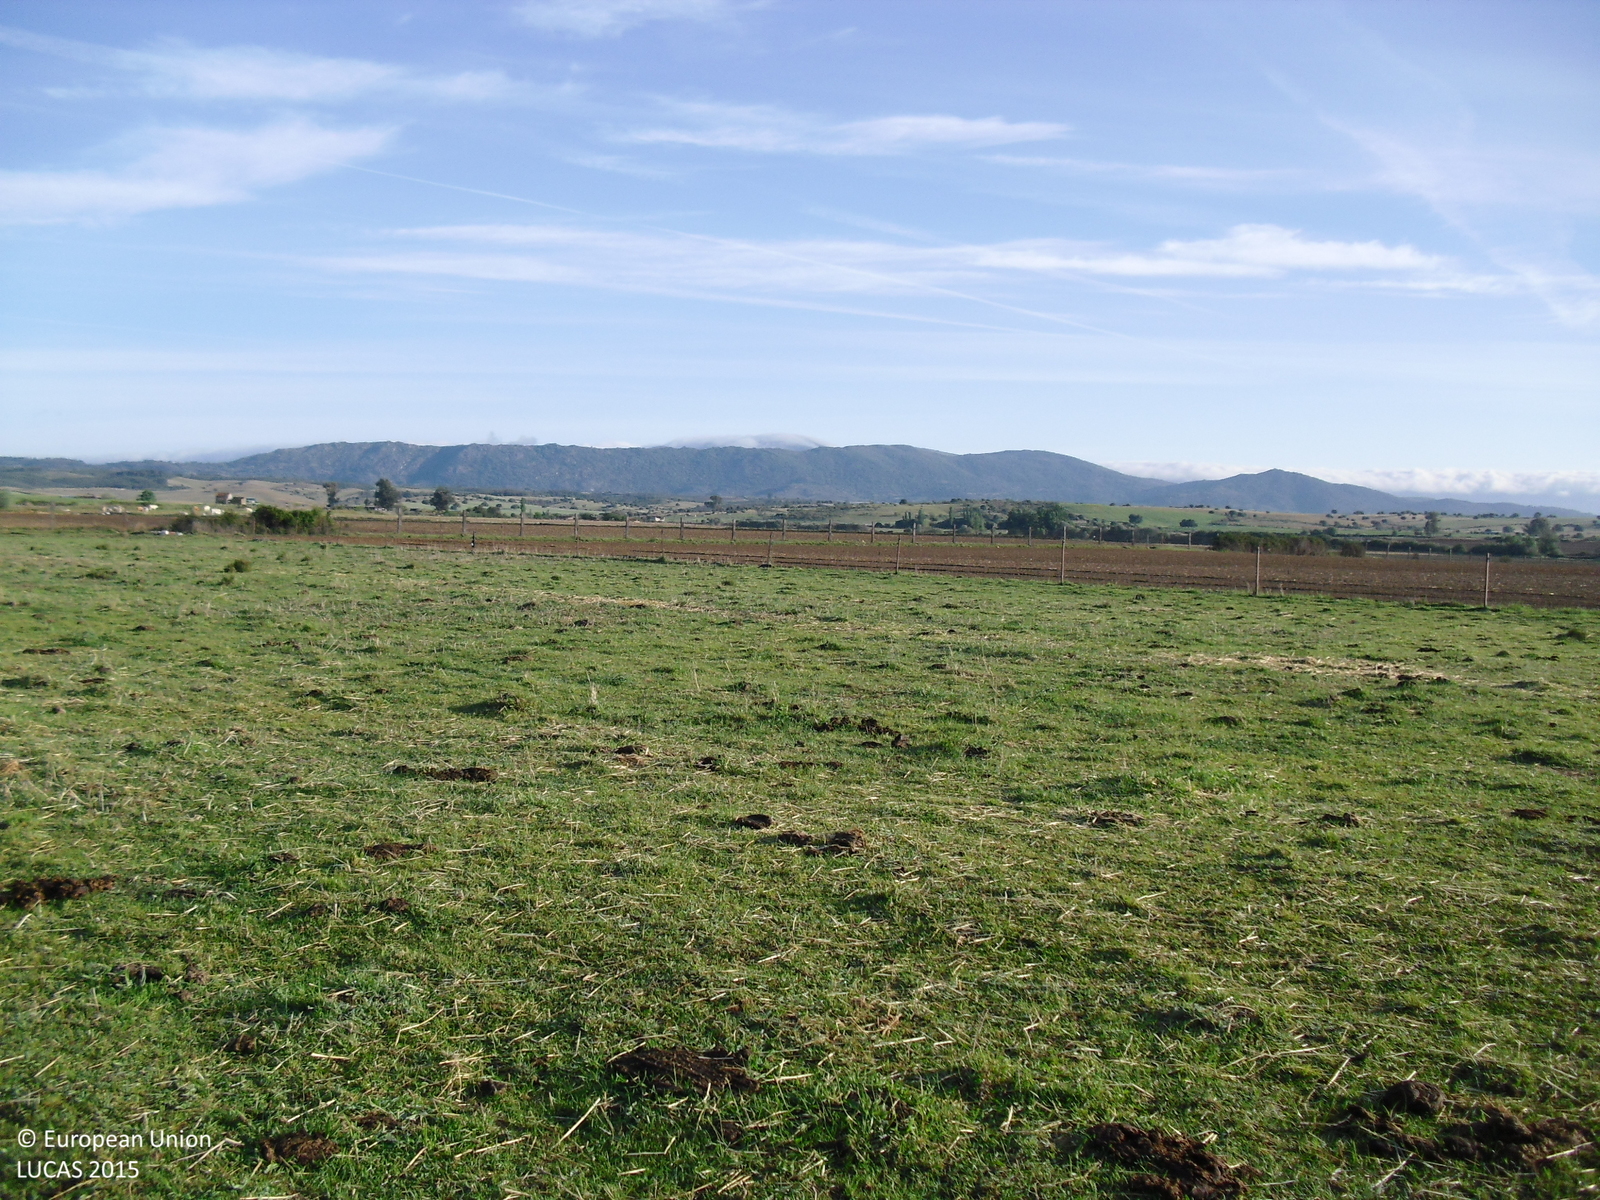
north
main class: Cropland
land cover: Temporary grasslands
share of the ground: > 75 %
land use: Agriculture (excluding fallow land and kitchen gardens)
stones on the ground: < 10 %
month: April
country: ES
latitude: 40.0478
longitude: -6.7656
